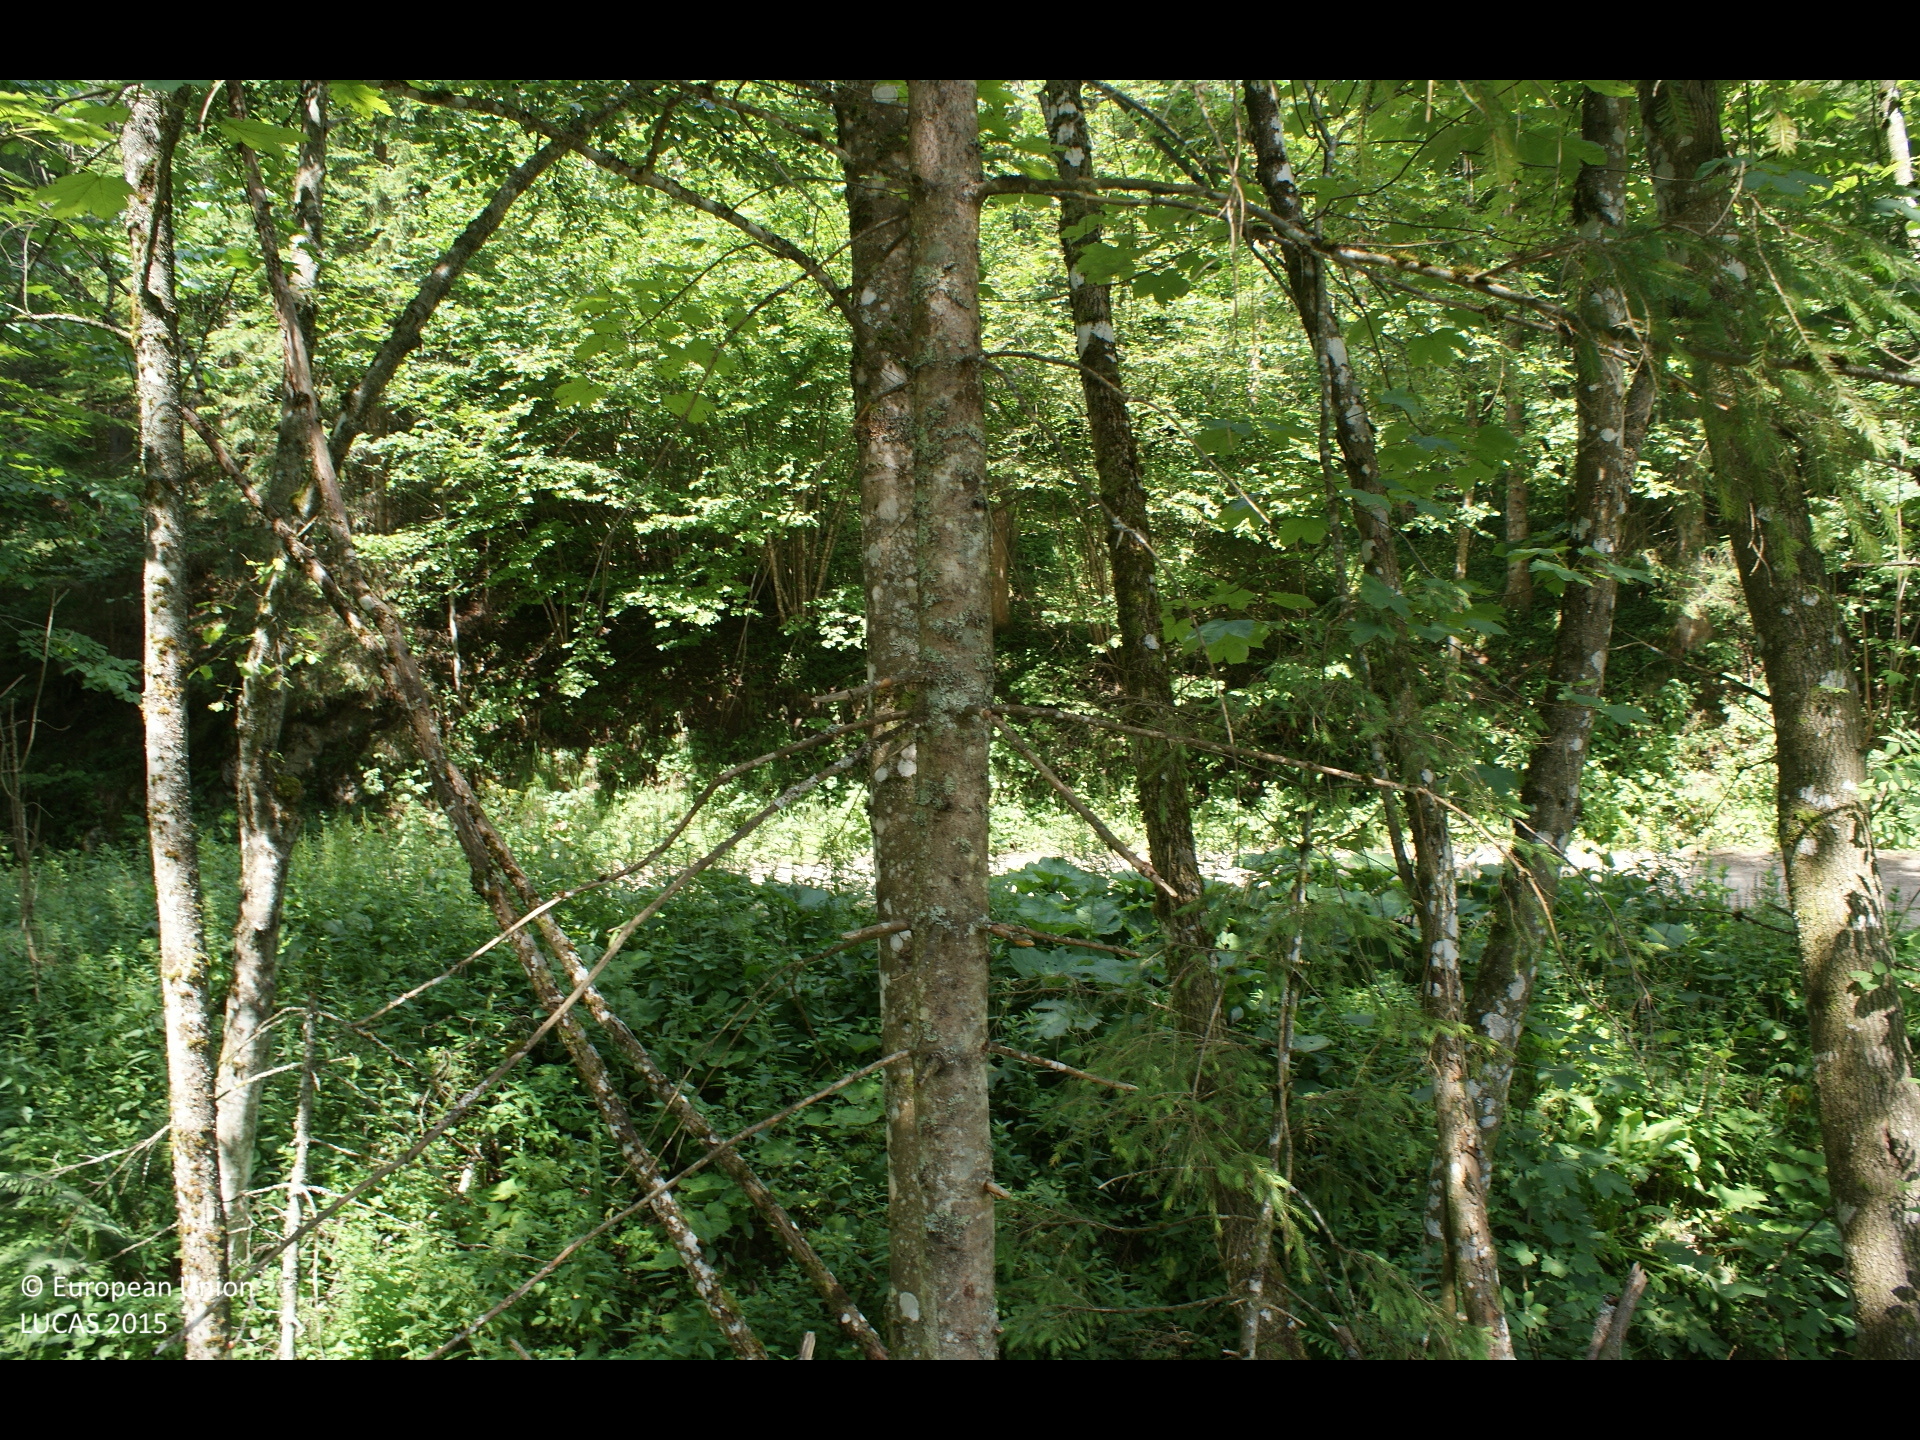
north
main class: Woodland
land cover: Spruce dominated mixed woodland
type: mesophytic deciduous forest
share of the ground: > 75 %
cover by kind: coniferous forest trees 55 %, broadleaved forest trees 30 %, herbaceous plants 10 %, shrubs 5 %
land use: Forestry
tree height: > 5 m
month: July
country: AT
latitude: 47.8600
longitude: 15.3345
